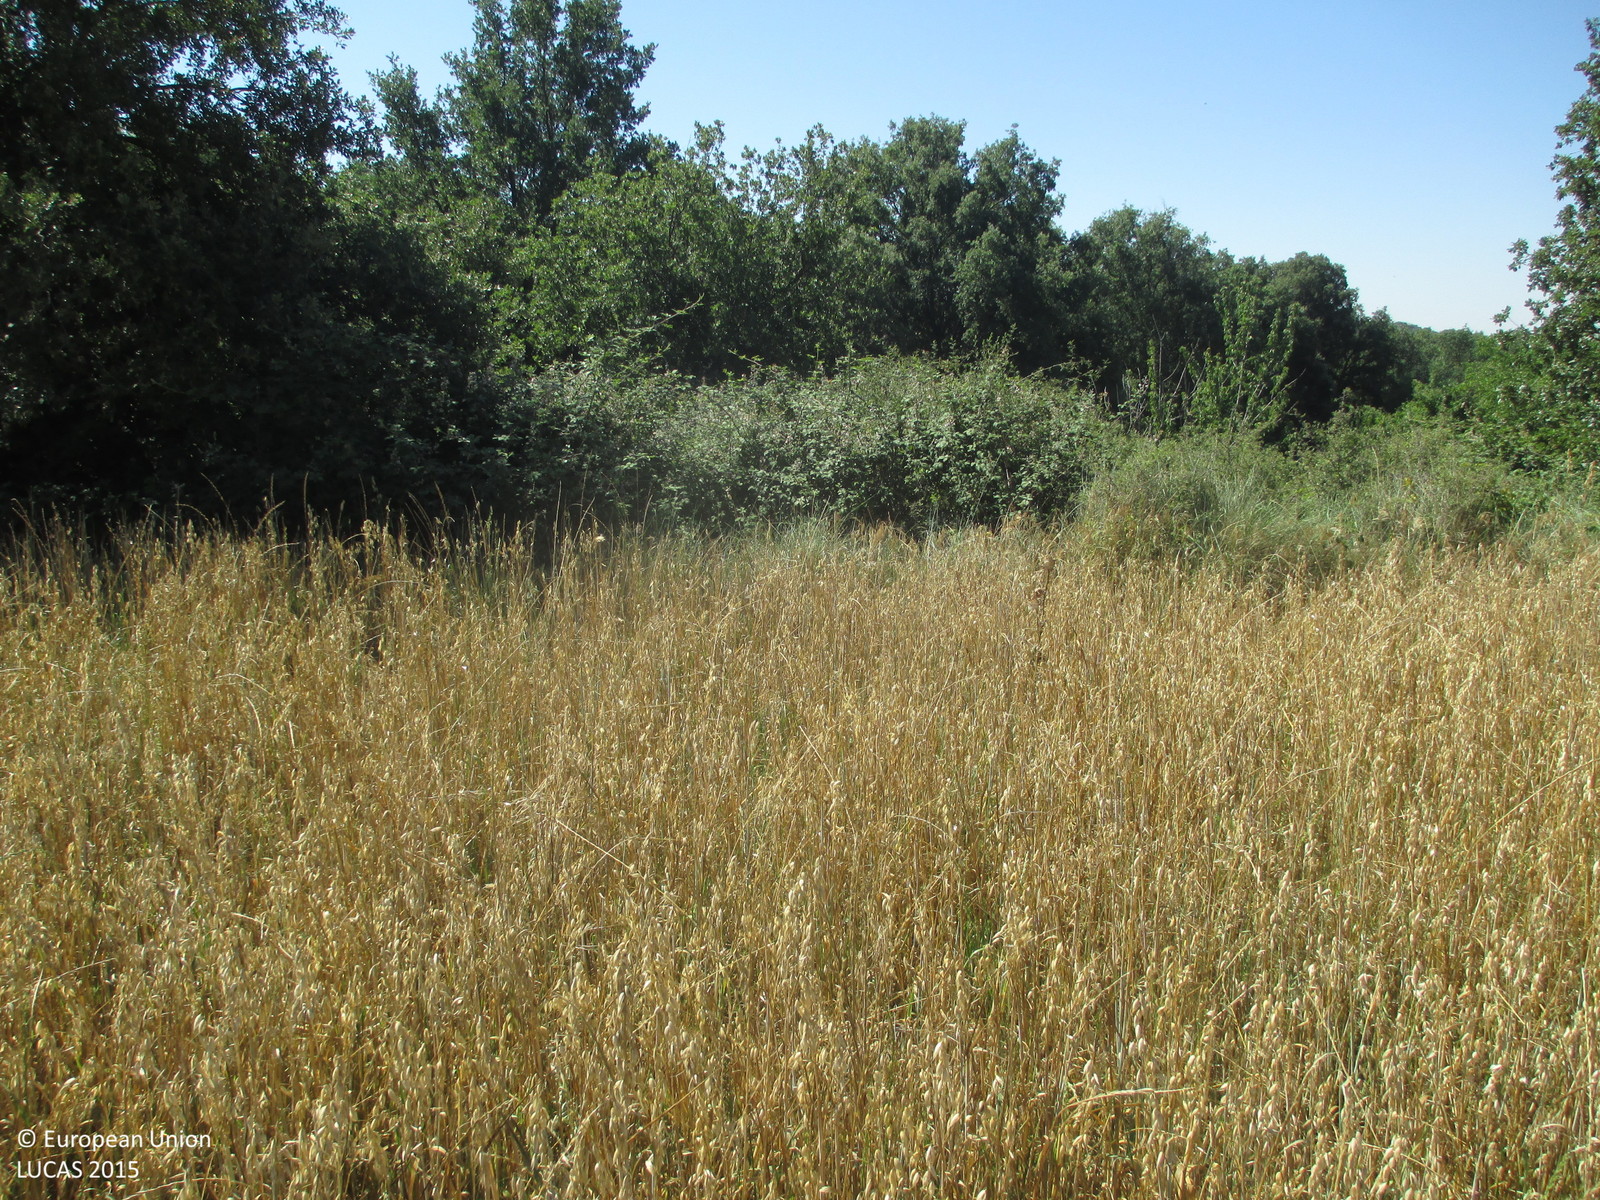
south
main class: Cropland
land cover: Mixed cereals for fodder
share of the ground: > 75 %
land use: Agriculture (excluding fallow land and kitchen gardens)
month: June
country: ES
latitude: 42.1730
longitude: -0.0317
